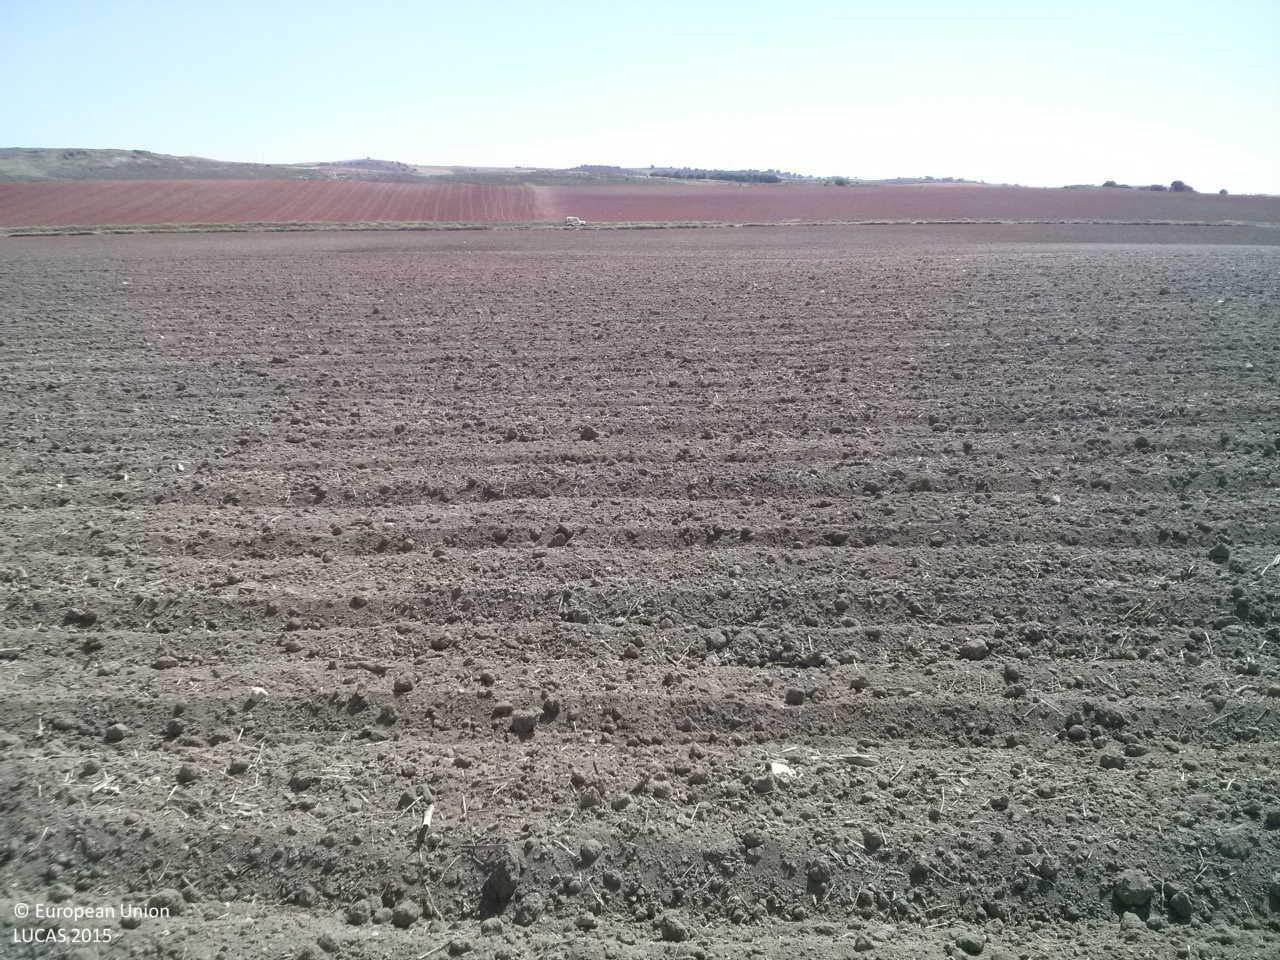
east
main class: Cropland
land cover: Sunflower
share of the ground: < 10 %
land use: Agriculture (excluding fallow land and kitchen gardens)
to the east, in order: Sunflower; Grass margins; Tracks; Grass margins; Sunflower
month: May
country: ES
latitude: 39.8115
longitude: -2.5033
